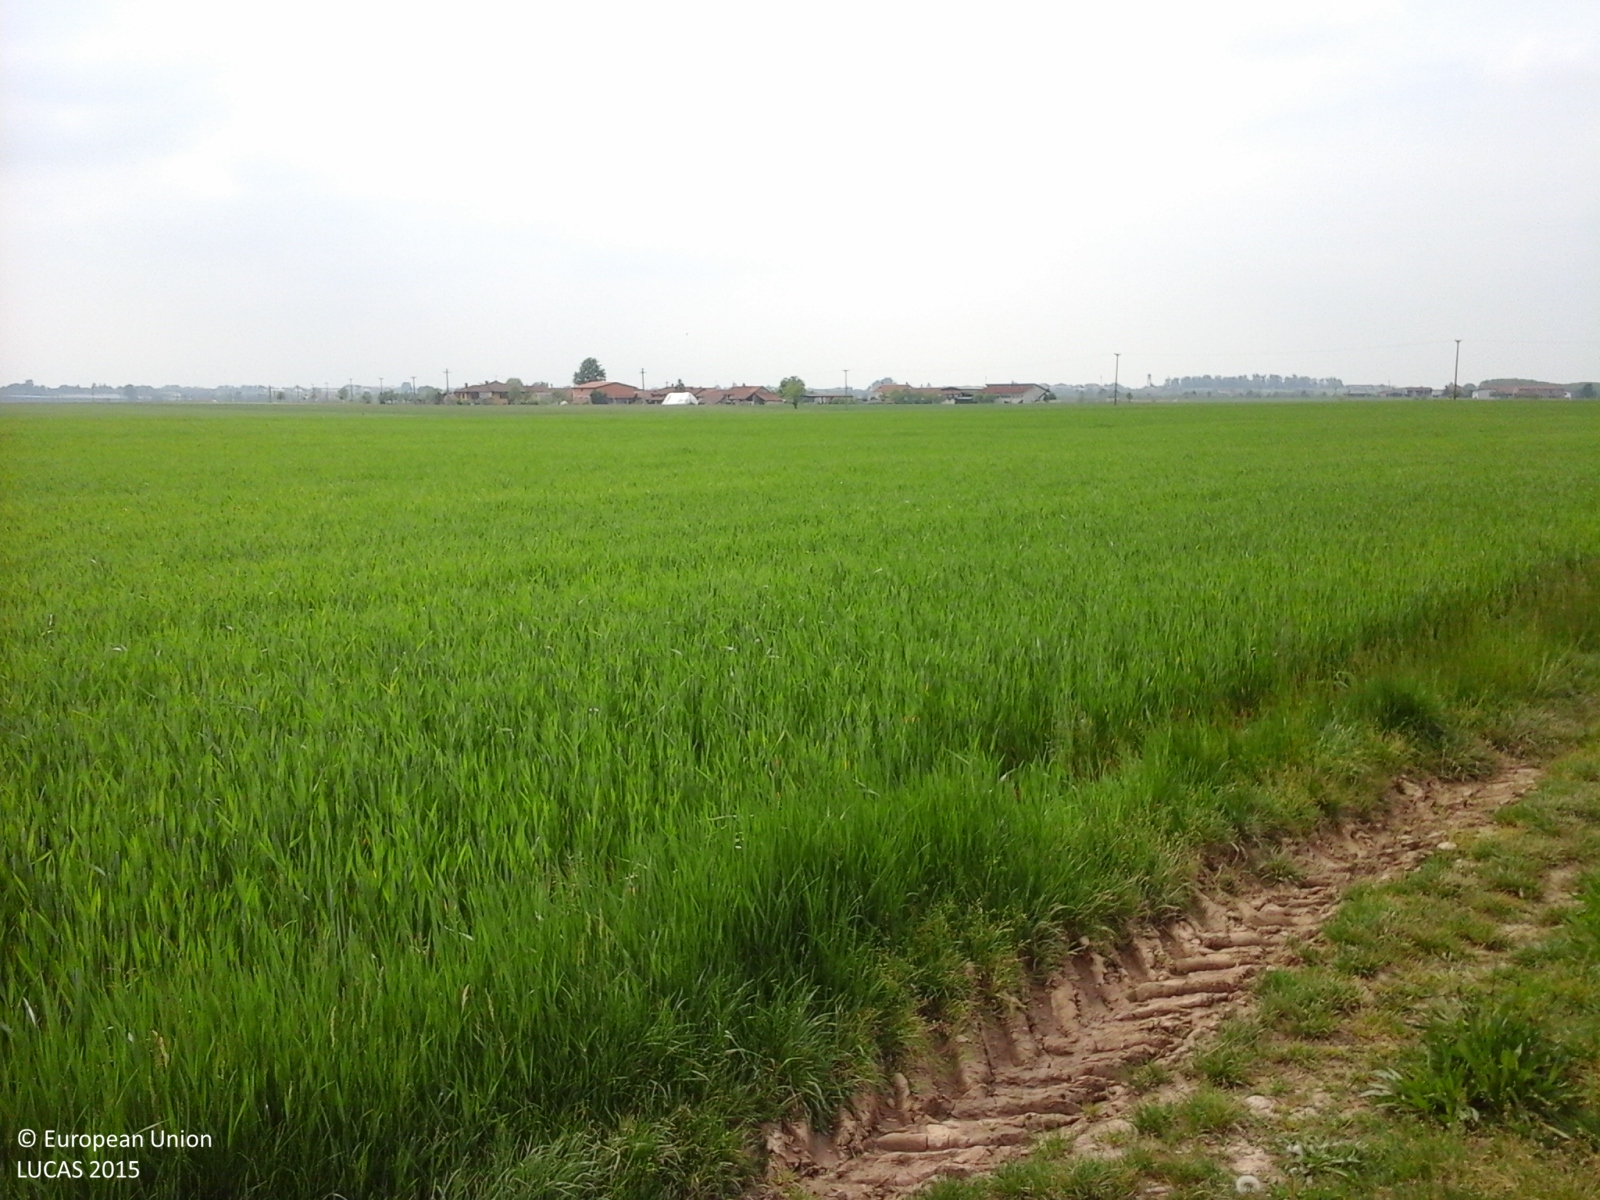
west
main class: Cropland
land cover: Common wheat
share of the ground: > 75 %
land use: Agriculture (excluding fallow land and kitchen gardens)
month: May
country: IT
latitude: 44.5623
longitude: 7.8263
